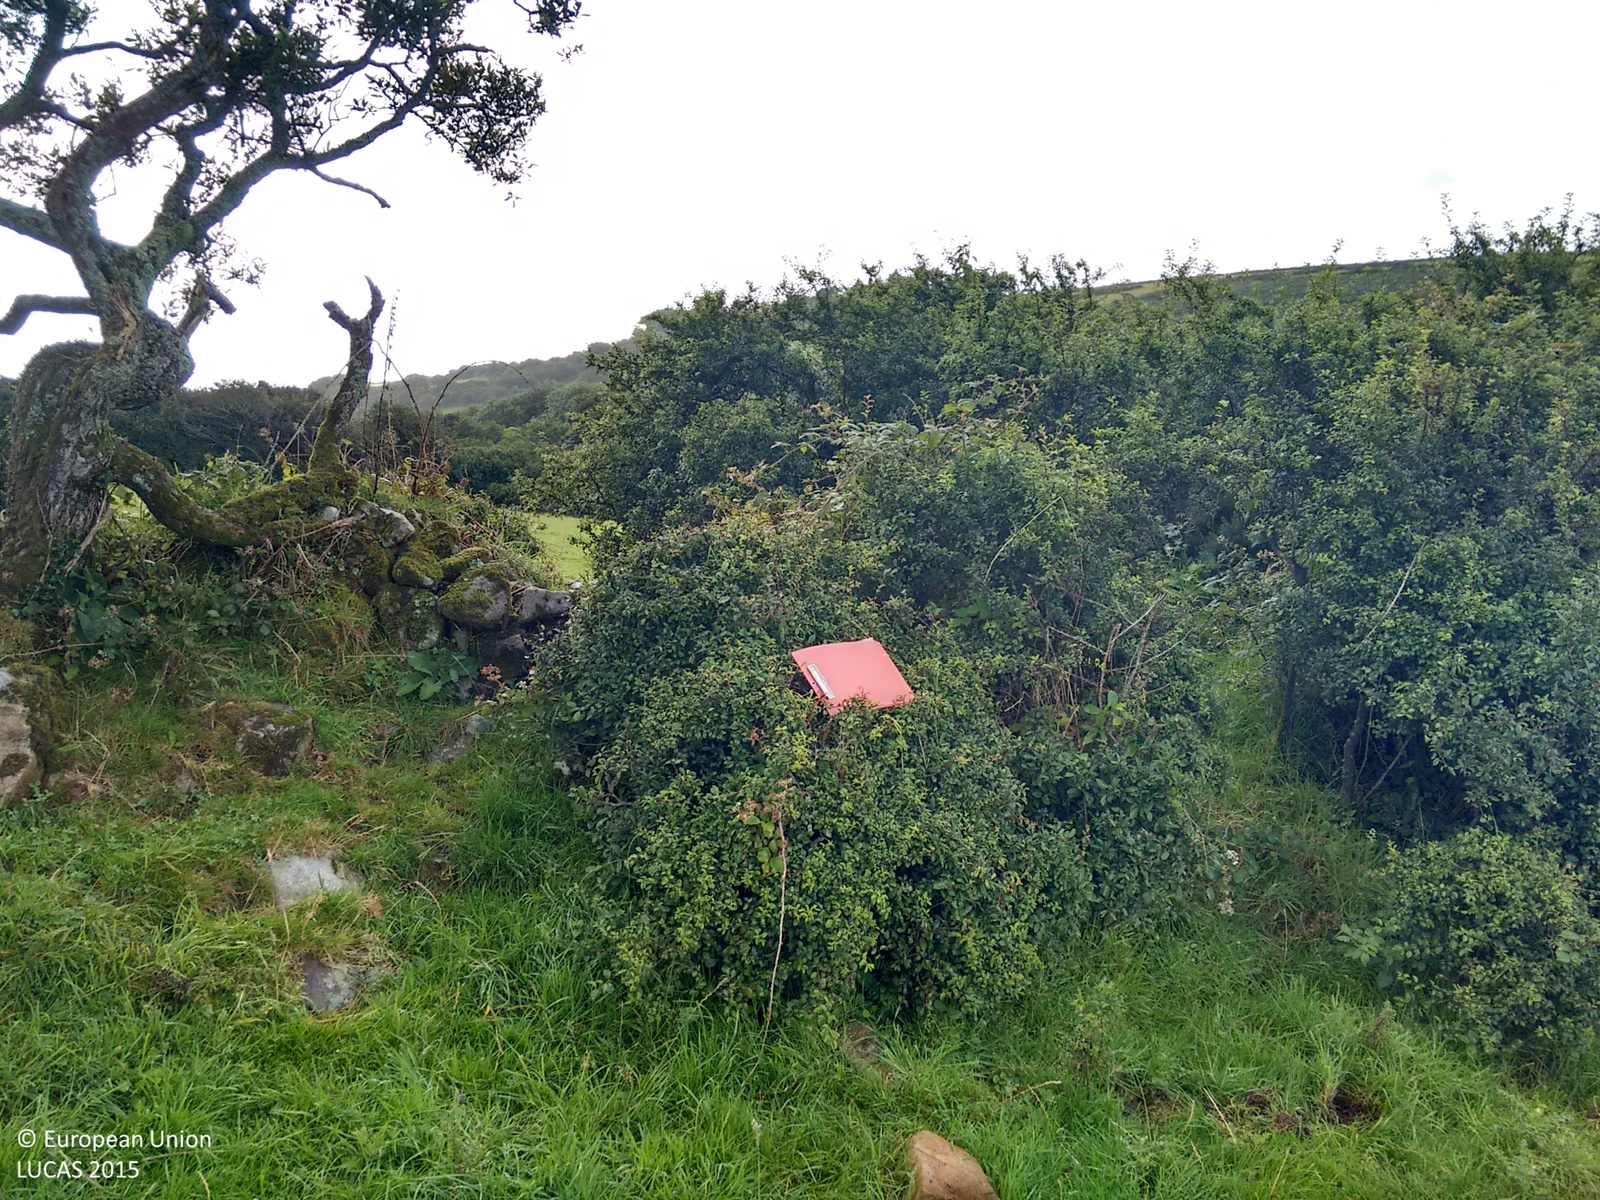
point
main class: Grassland
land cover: Grassland without tree/shrub cover
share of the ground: > 75 %
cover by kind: herbaceous plants 100 %
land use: Agriculture (excluding fallow land and kitchen gardens)
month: August
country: GB
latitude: 50.1757
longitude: -5.5167
